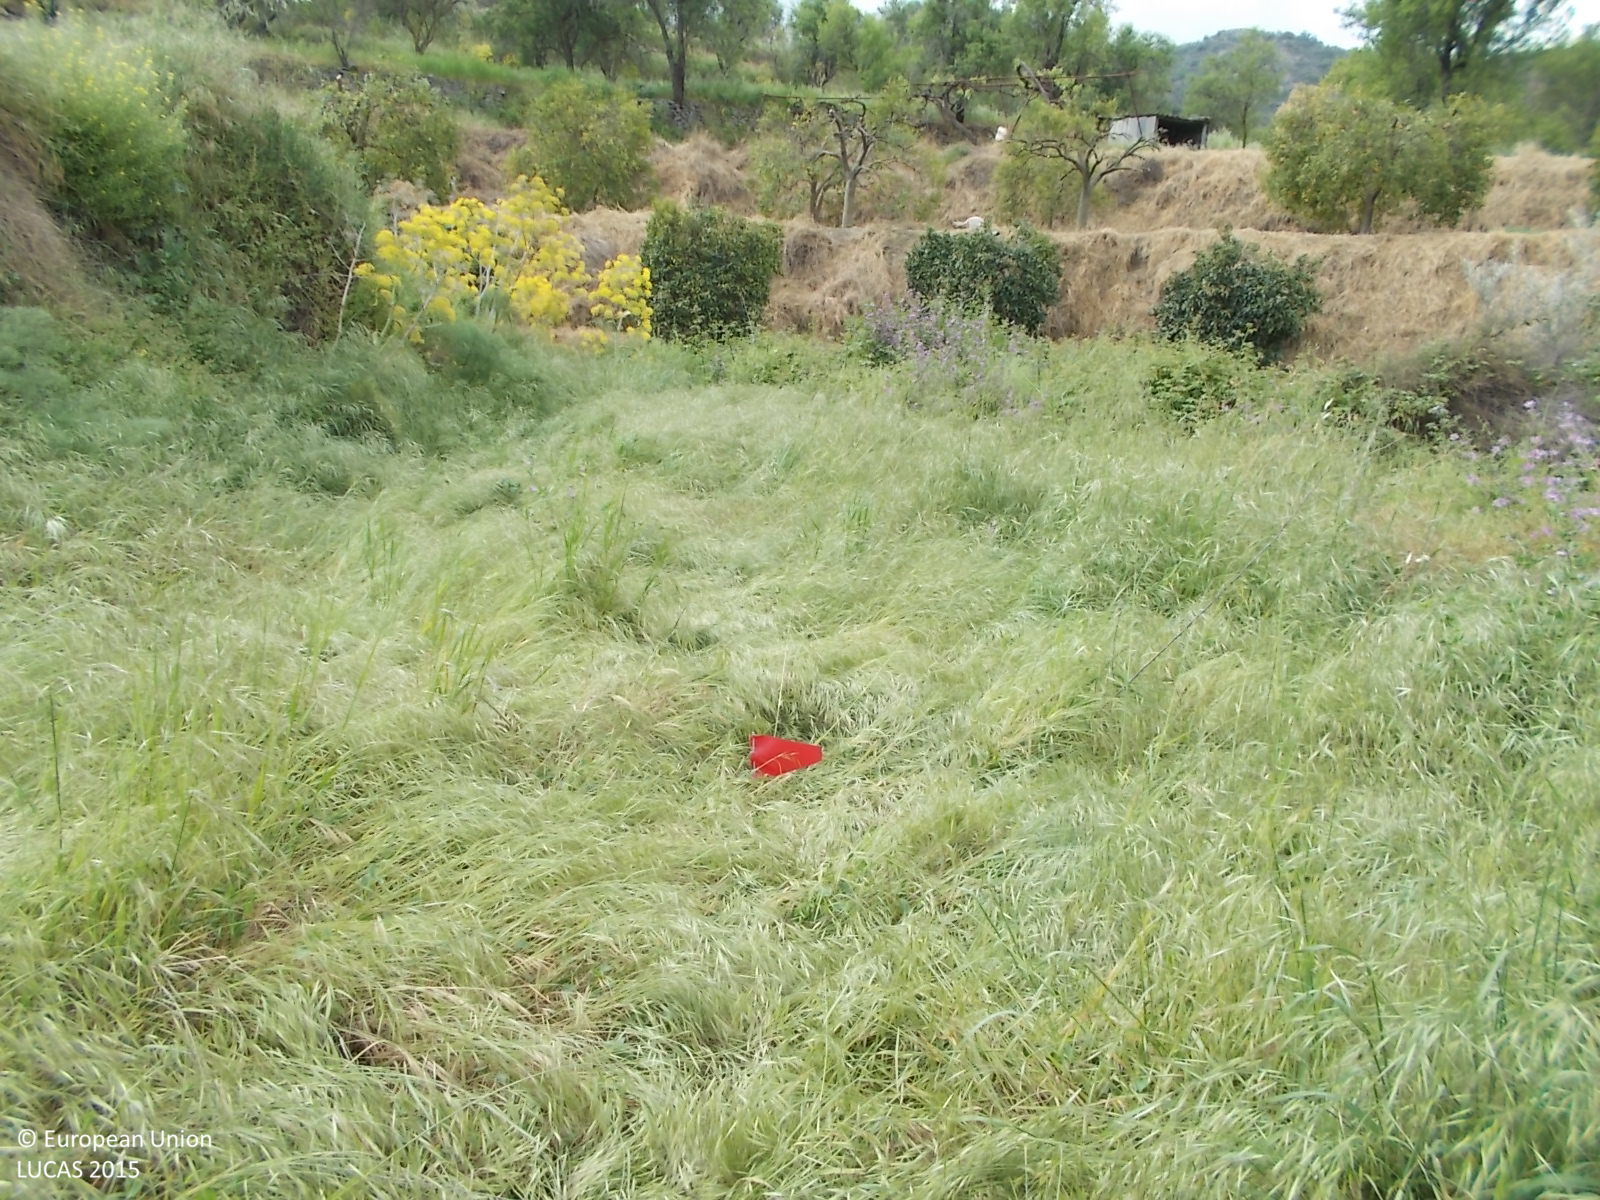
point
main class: Grassland
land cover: Spontaneously vegetated surfaces
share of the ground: > 75 %
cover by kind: herbaceous plants 100 %
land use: Fallow land
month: April
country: CY
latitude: 34.8140
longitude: 33.1414
